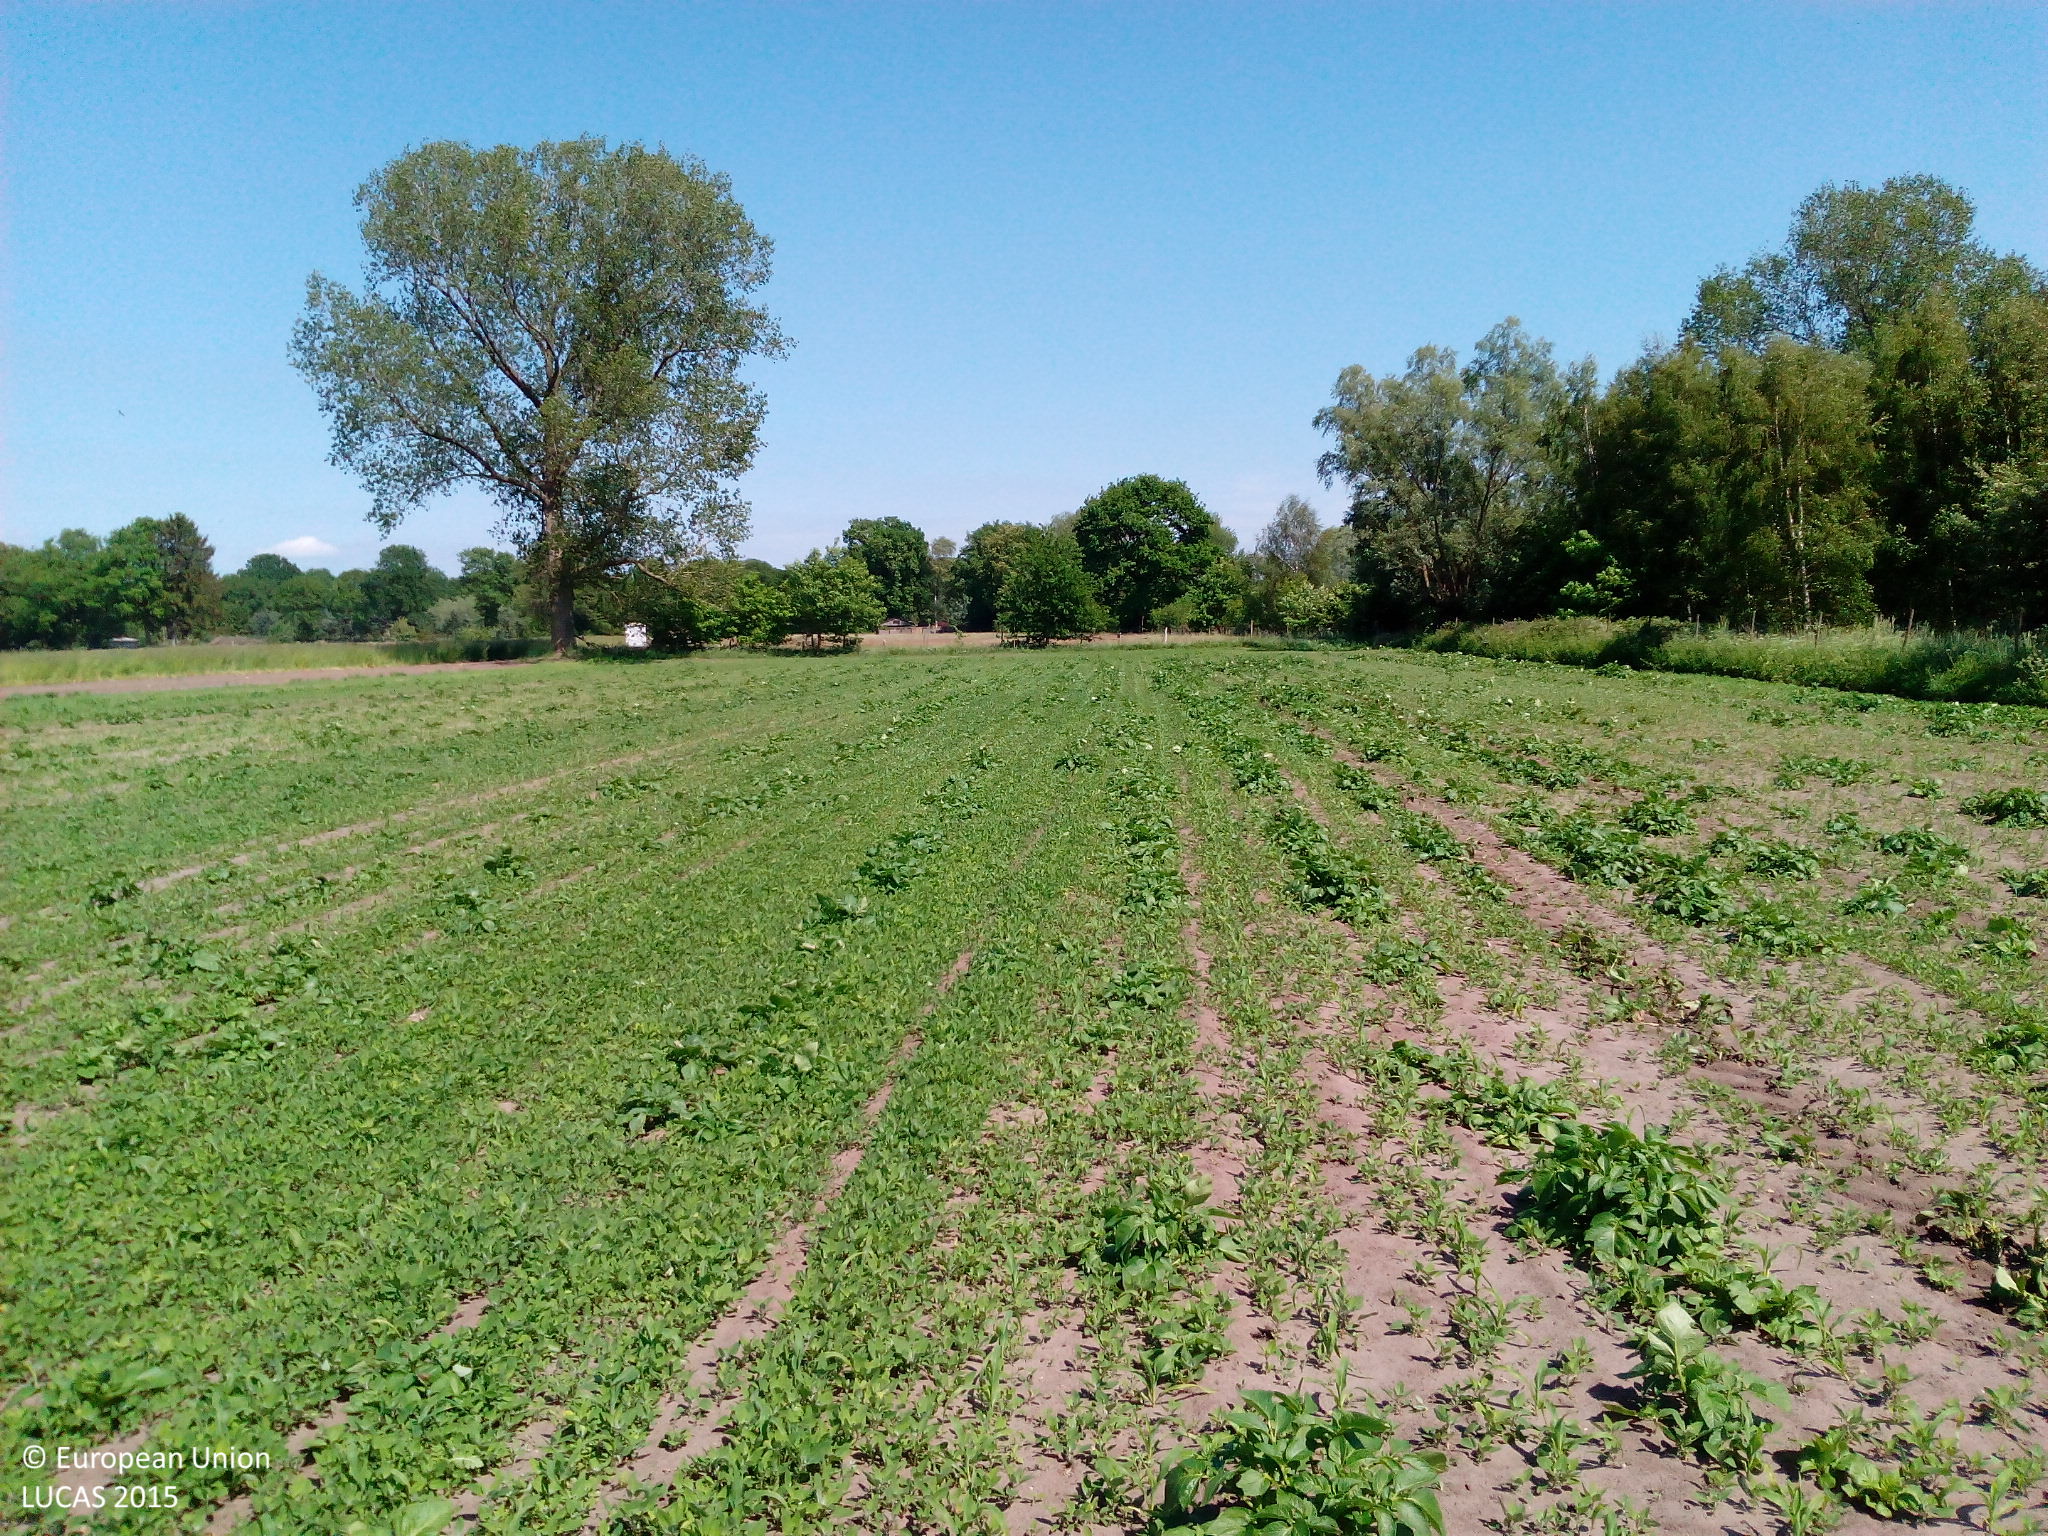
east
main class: Cropland
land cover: Maize
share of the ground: 10 - 25 %
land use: Agriculture (excluding fallow land and kitchen gardens)
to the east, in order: Maize; Fences; Single bushes/trees; Ditches and canals; Fences; Grassland without tree/shrub cover; Fences; Shrubland with sparse tree cover; Grassland without tree/shrub cover; Broadleaved woodland; Fences; Grassland without tree/shrub cover
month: June
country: DE
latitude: 53.7069
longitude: 9.6518
